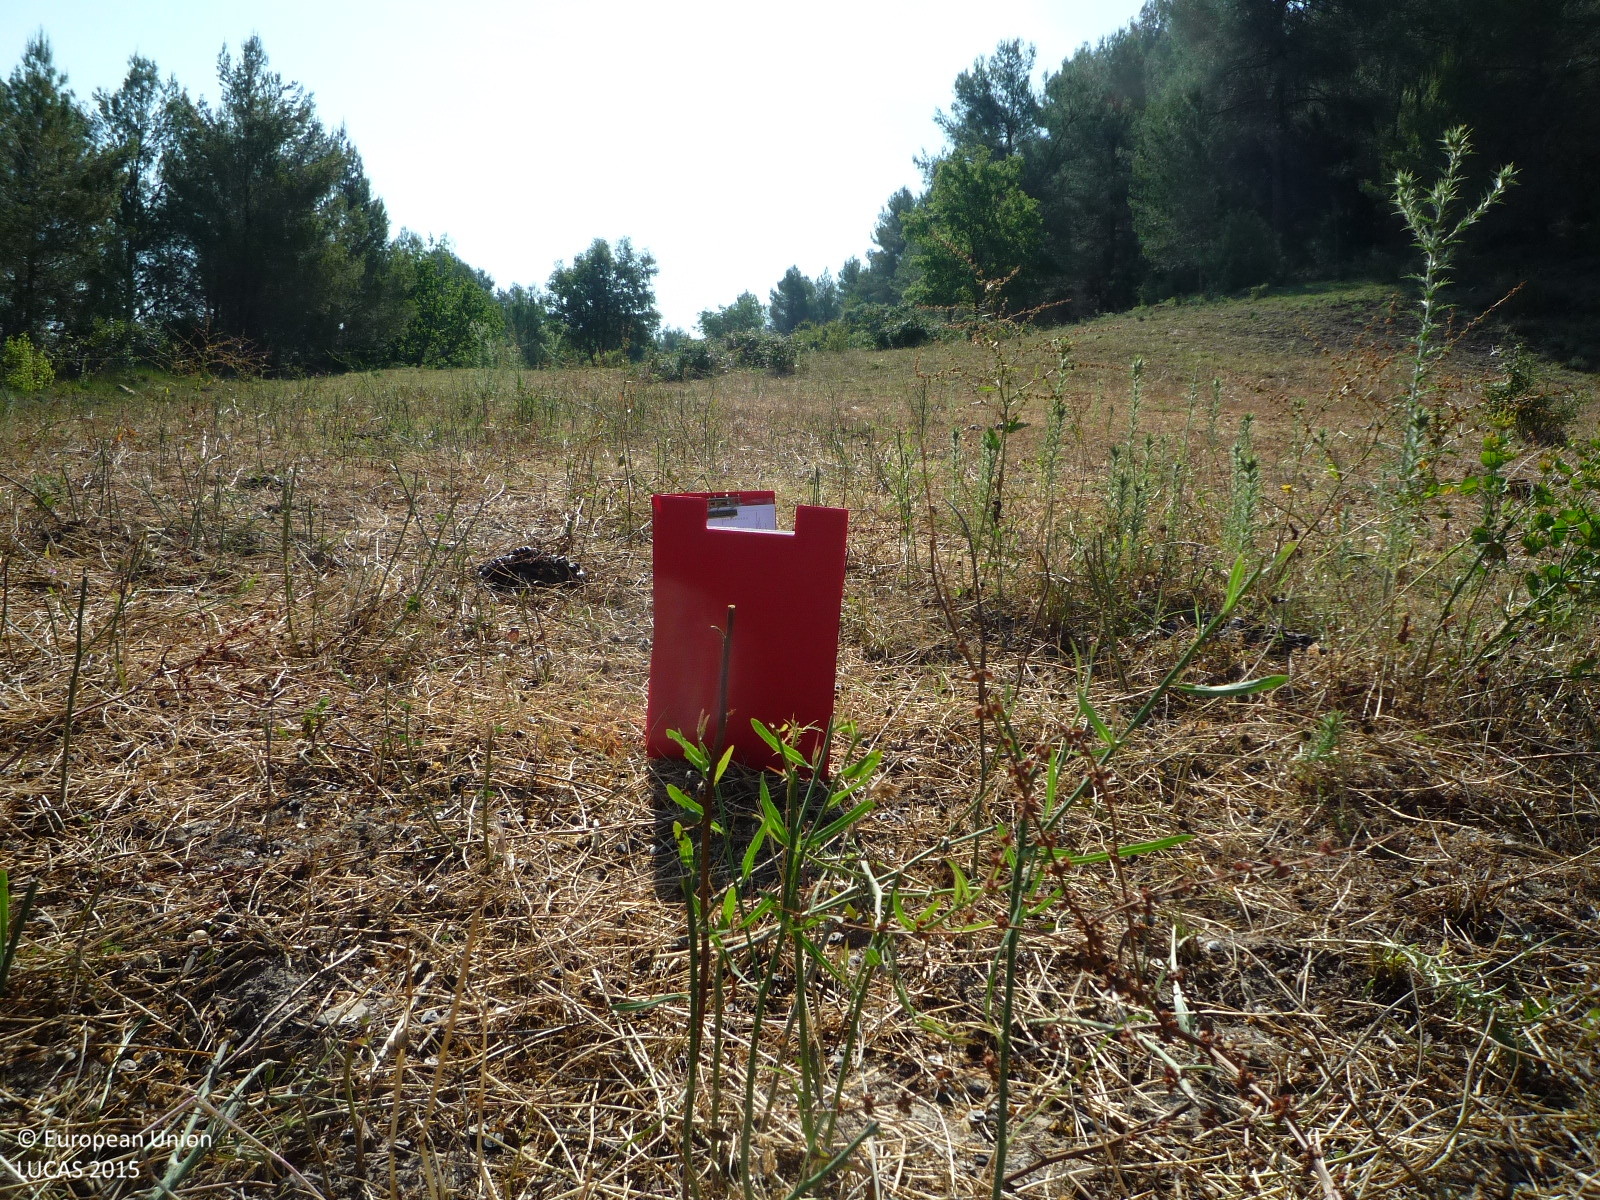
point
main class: Cropland
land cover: Temporary grasslands
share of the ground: > 75 %
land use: Agriculture (excluding fallow land and kitchen gardens)
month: June
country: ES
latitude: 41.6488
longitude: 1.7908
